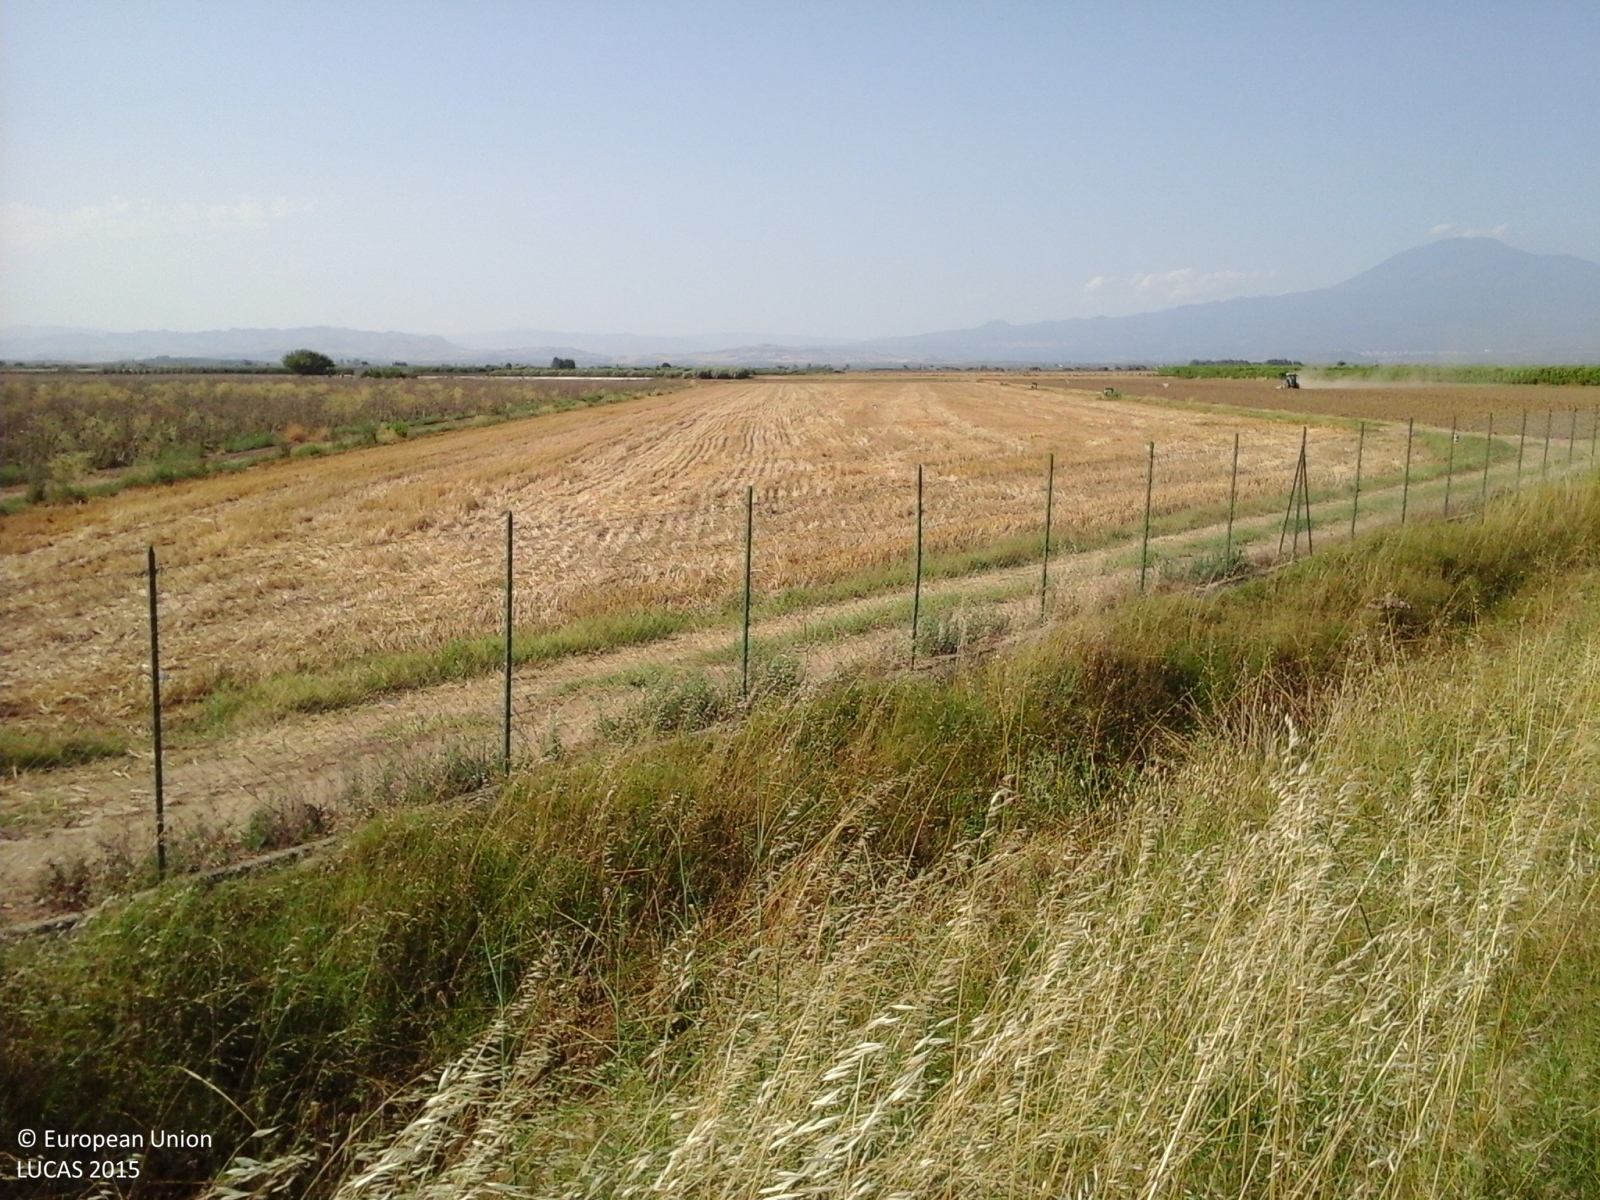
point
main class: Cropland
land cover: Common wheat
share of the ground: > 75 %
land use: Agriculture (excluding fallow land and kitchen gardens)
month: June
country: IT
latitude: 37.4064
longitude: 14.8336
